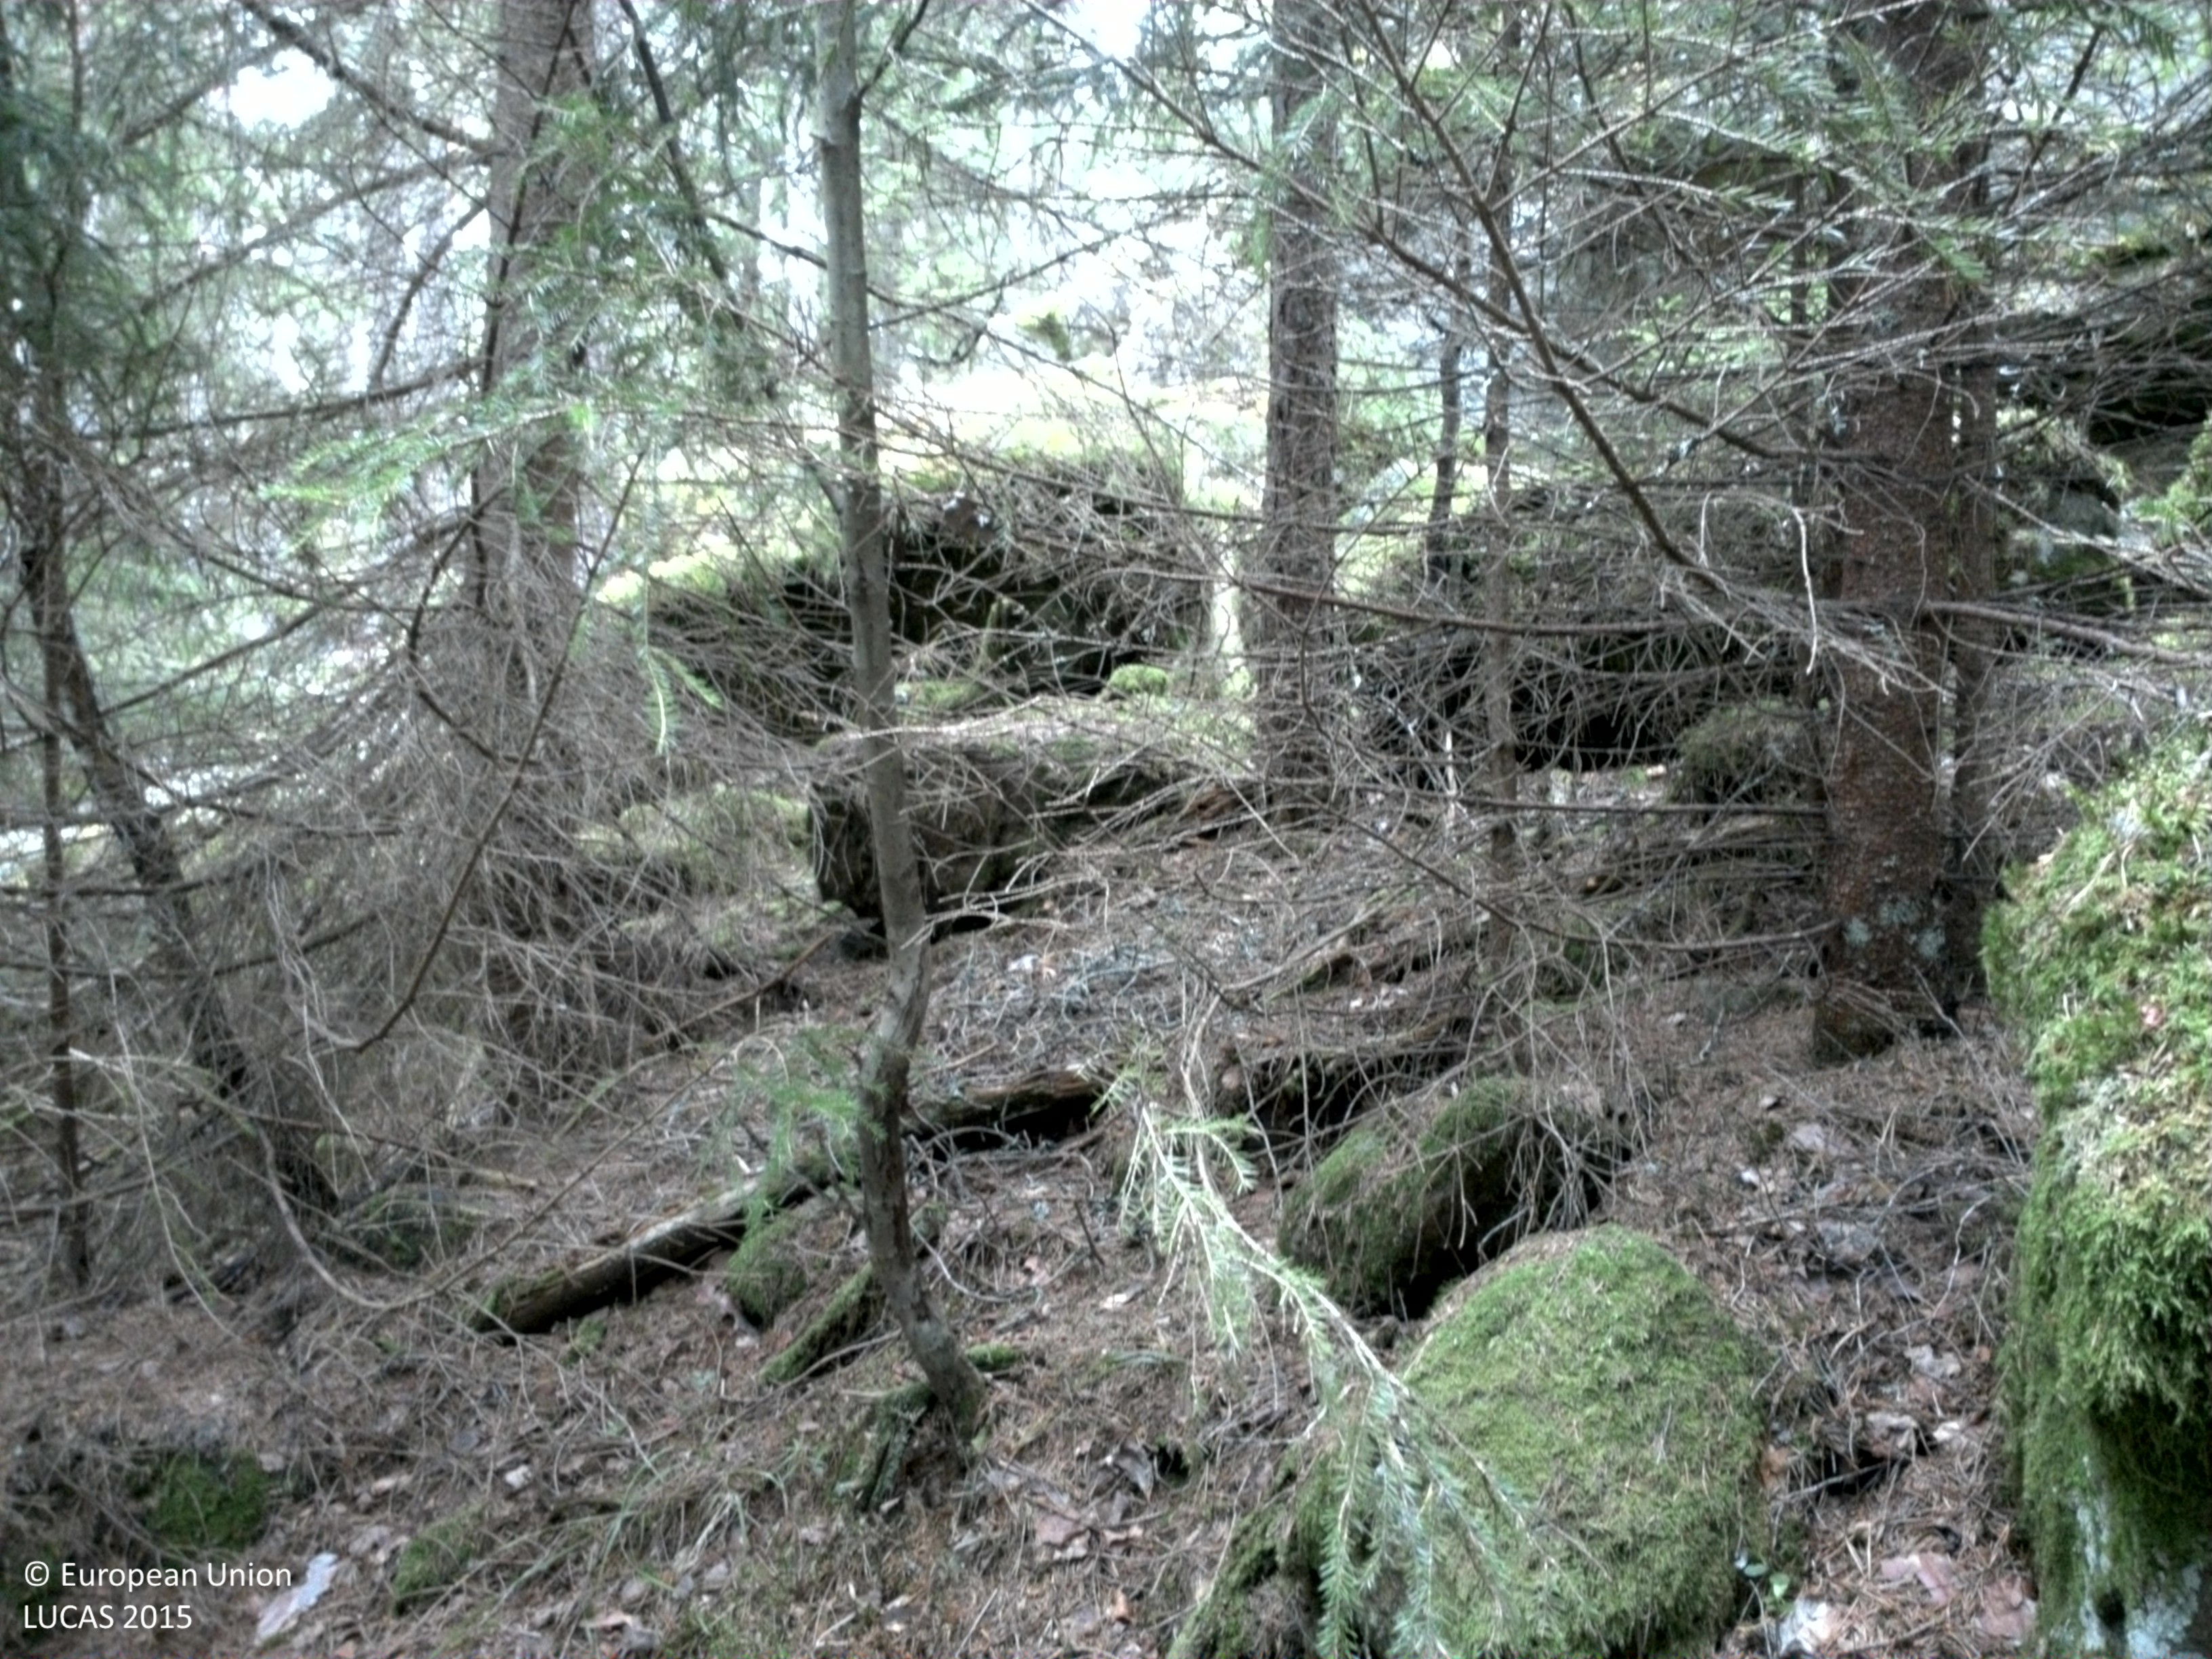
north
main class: Woodland
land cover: Spruce dominated coniferous woodland
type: boreal forest
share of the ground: 50 - 75 %
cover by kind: coniferous forest trees 70 %, lichens and mosses 25 %, shrubs 5 %
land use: Forestry
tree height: > 5 m
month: August
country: SE
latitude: 59.3565
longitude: 11.9826
